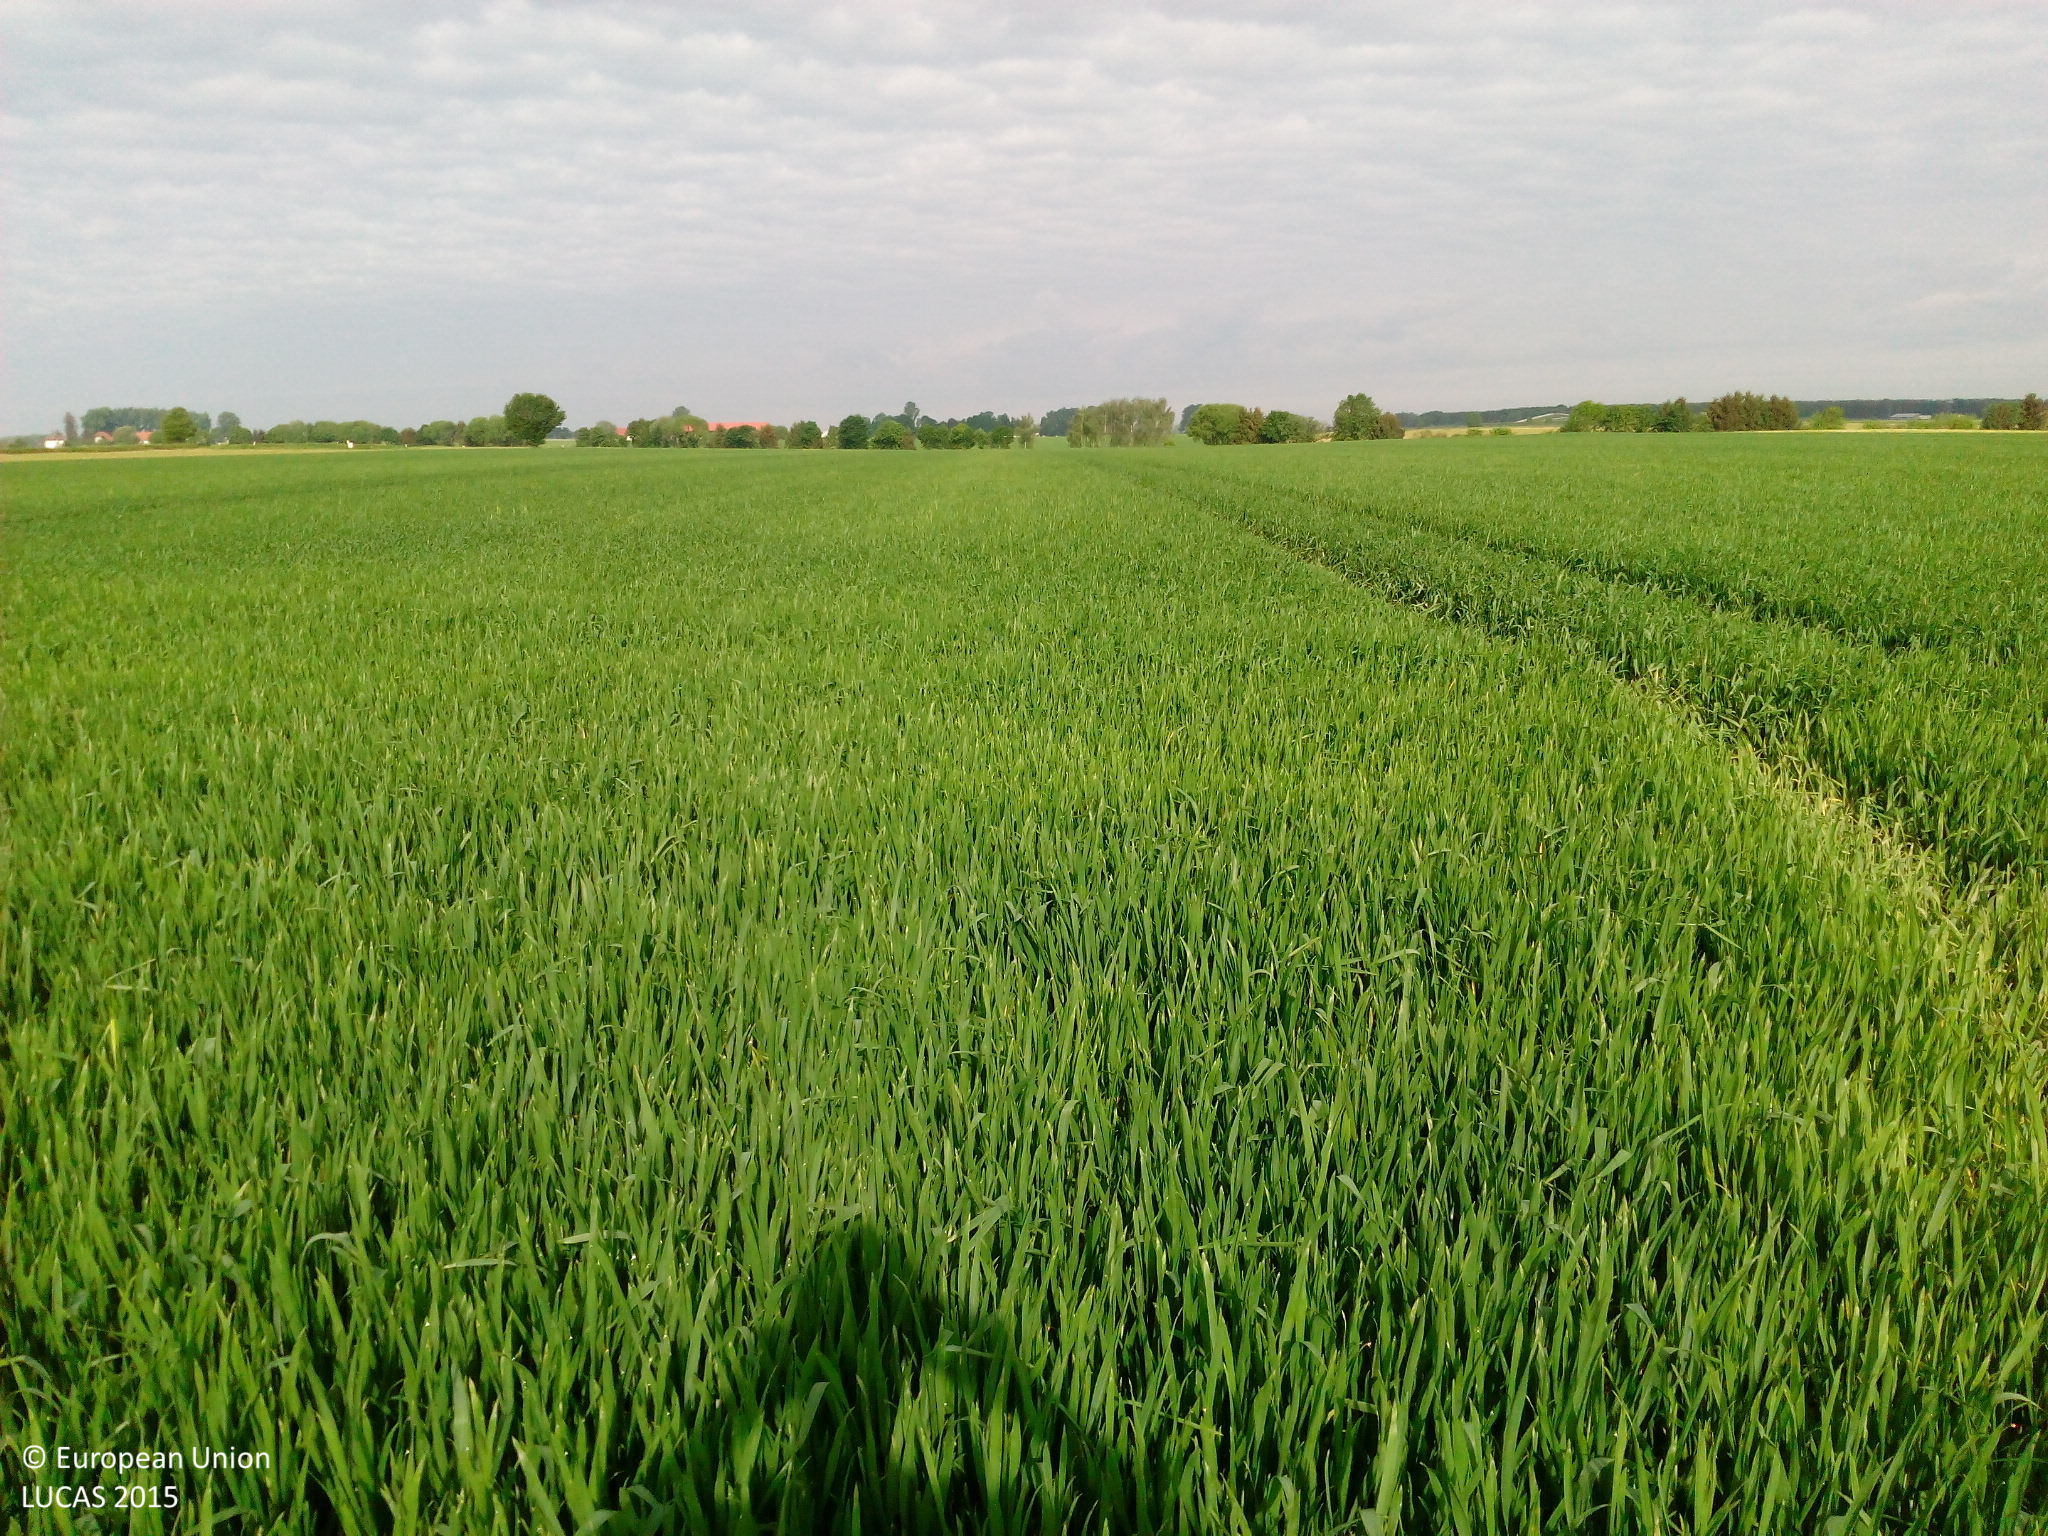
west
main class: Cropland
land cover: Common wheat
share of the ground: > 75 %
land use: Agriculture (excluding fallow land and kitchen gardens)
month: May
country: DE
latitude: 47.9713
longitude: 10.2543
